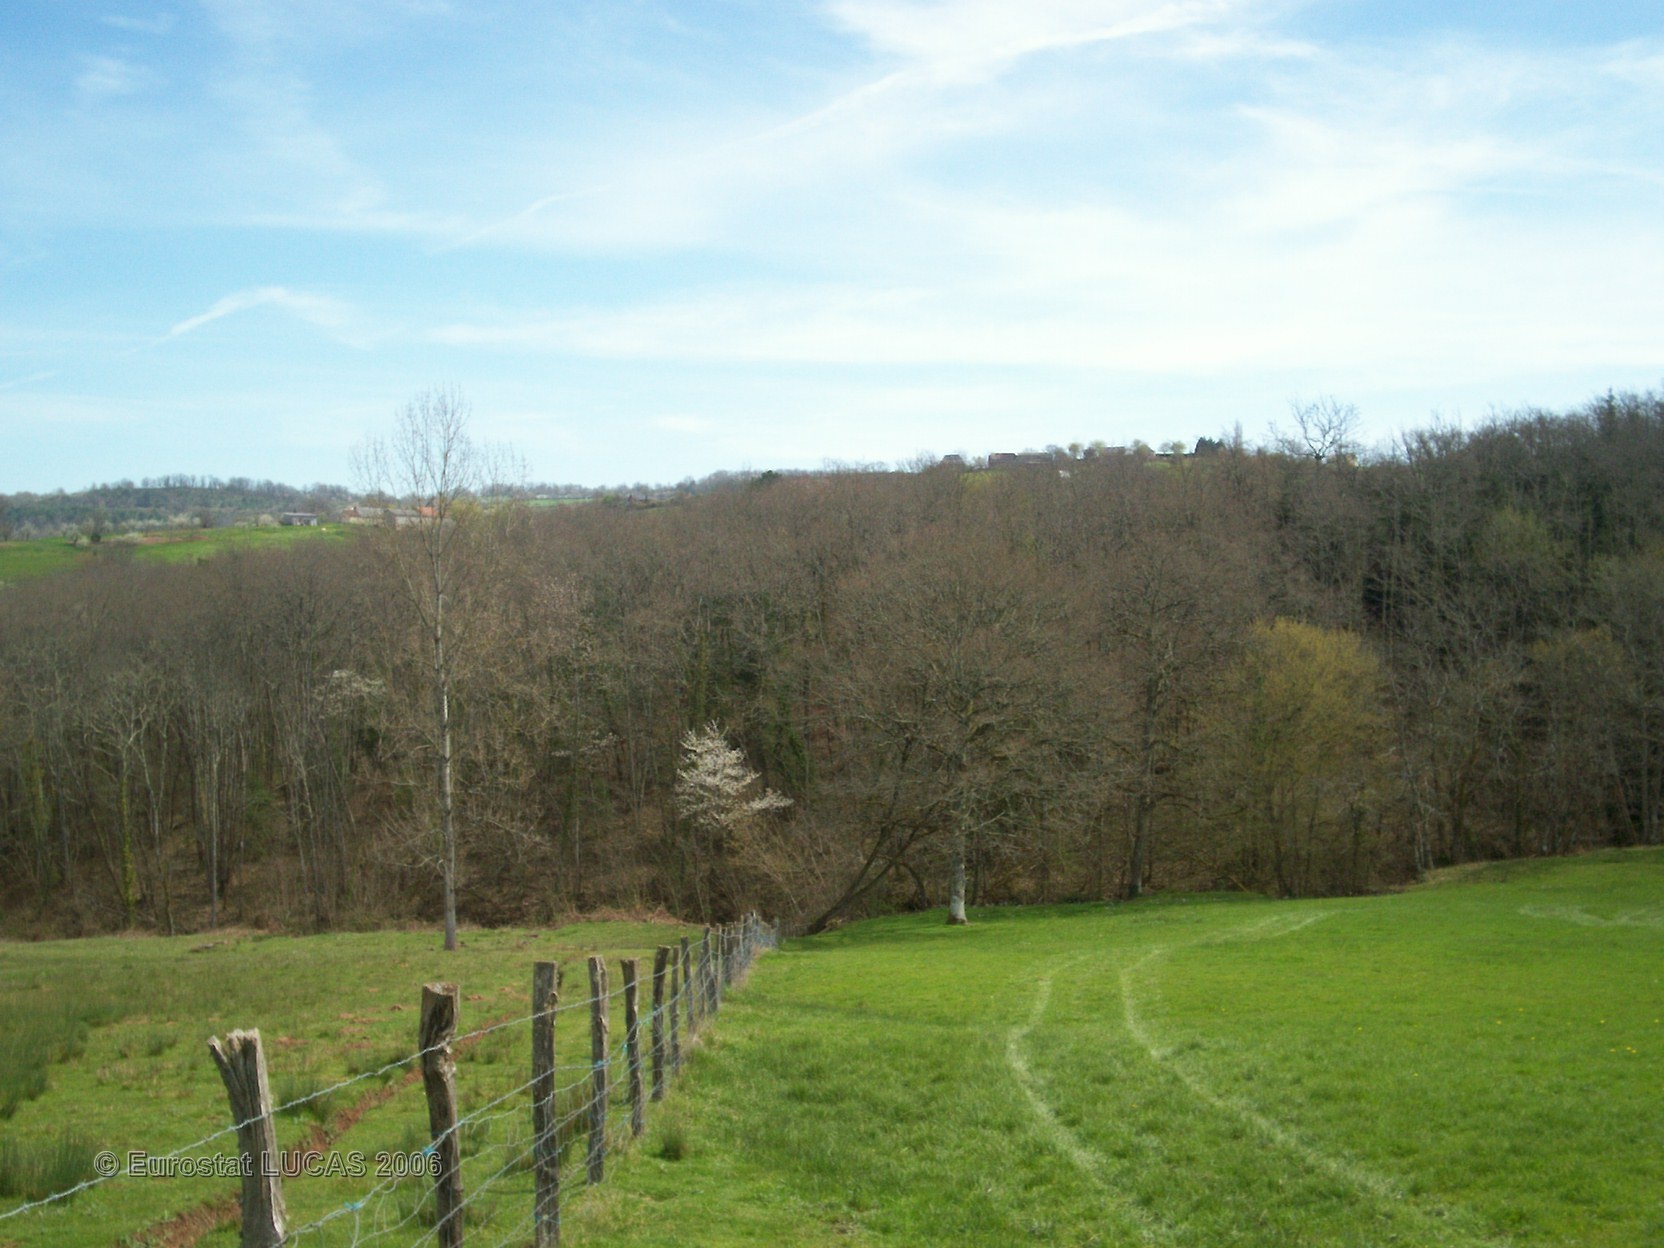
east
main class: Grassland
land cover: Grassland without tree/shrub cover
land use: Agriculture (excluding fallow land and kitchen gardens)
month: April
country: FR
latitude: 45.2169
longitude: 1.2964
